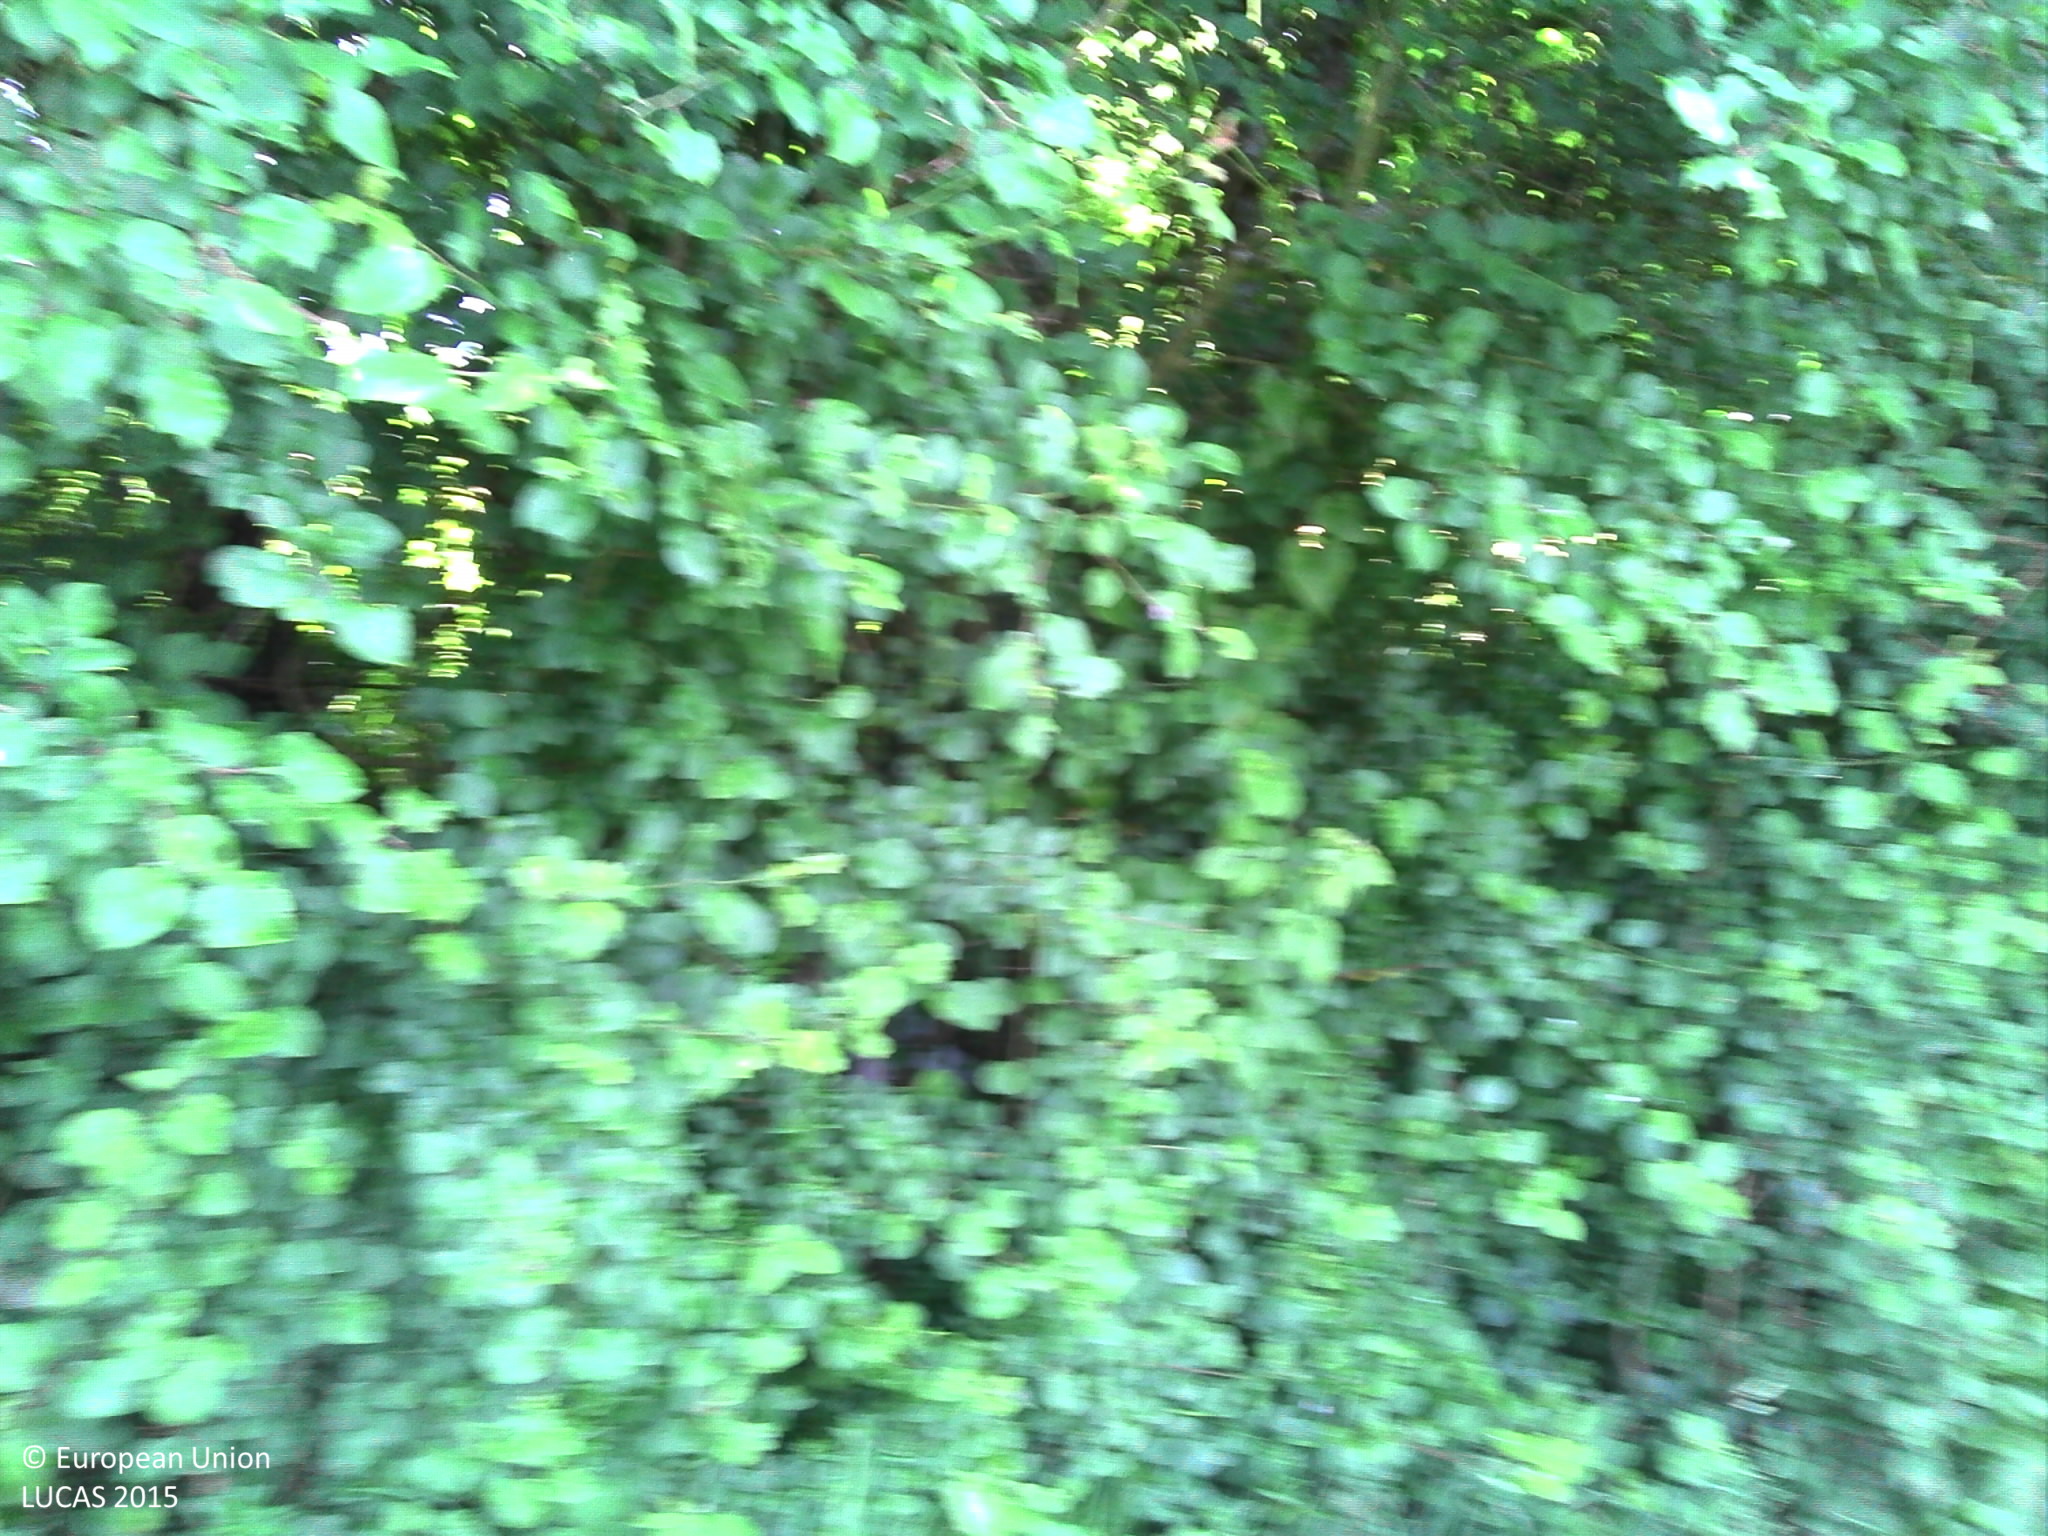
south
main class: Grassland
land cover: Grassland without tree/shrub cover
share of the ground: > 75 %
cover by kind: herbaceous plants 100 %
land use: Agriculture (excluding fallow land and kitchen gardens)
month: June
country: FR
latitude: 49.4308
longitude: -1.7314
